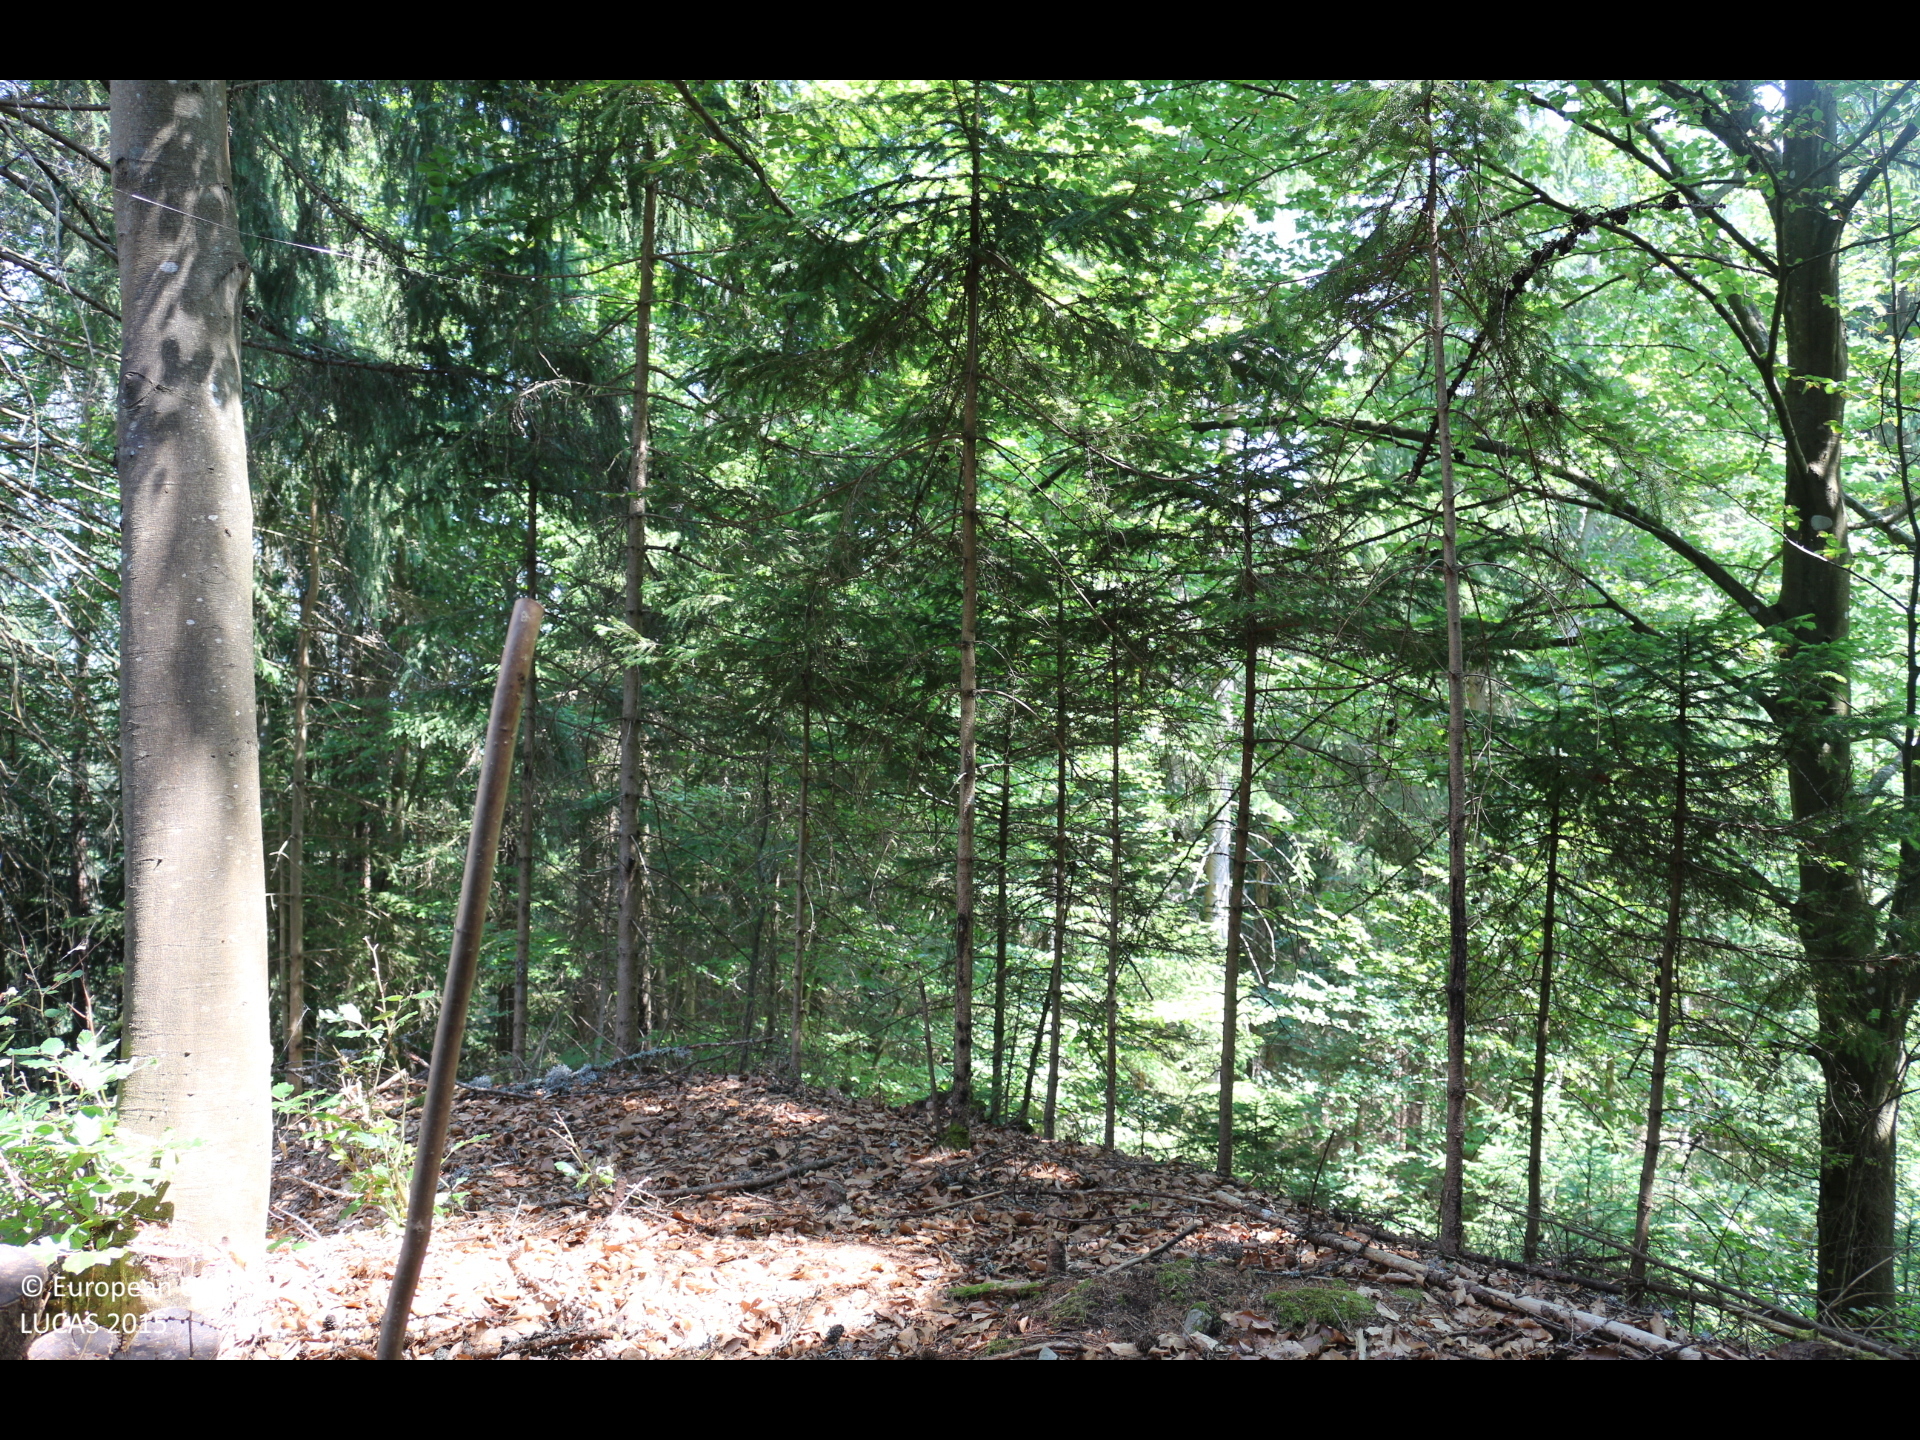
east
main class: Woodland
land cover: Spruce dominated coniferous woodland
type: alpine coniferous forest
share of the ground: > 75 %
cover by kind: coniferous forest trees 90 %, broadleaved forest trees 10 %
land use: Forestry
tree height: > 5 m
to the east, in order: Spruce dominated coniferous woodland; Spruce dominated mixed woodland; Tracks; Spruce dominated mixed woodland; Shrubland with sparse tree cover; Spruce dominated coniferous woodland; Tracks; Spruce dominated coniferous woodland
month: June
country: AT
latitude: 46.5478
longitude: 13.9749
